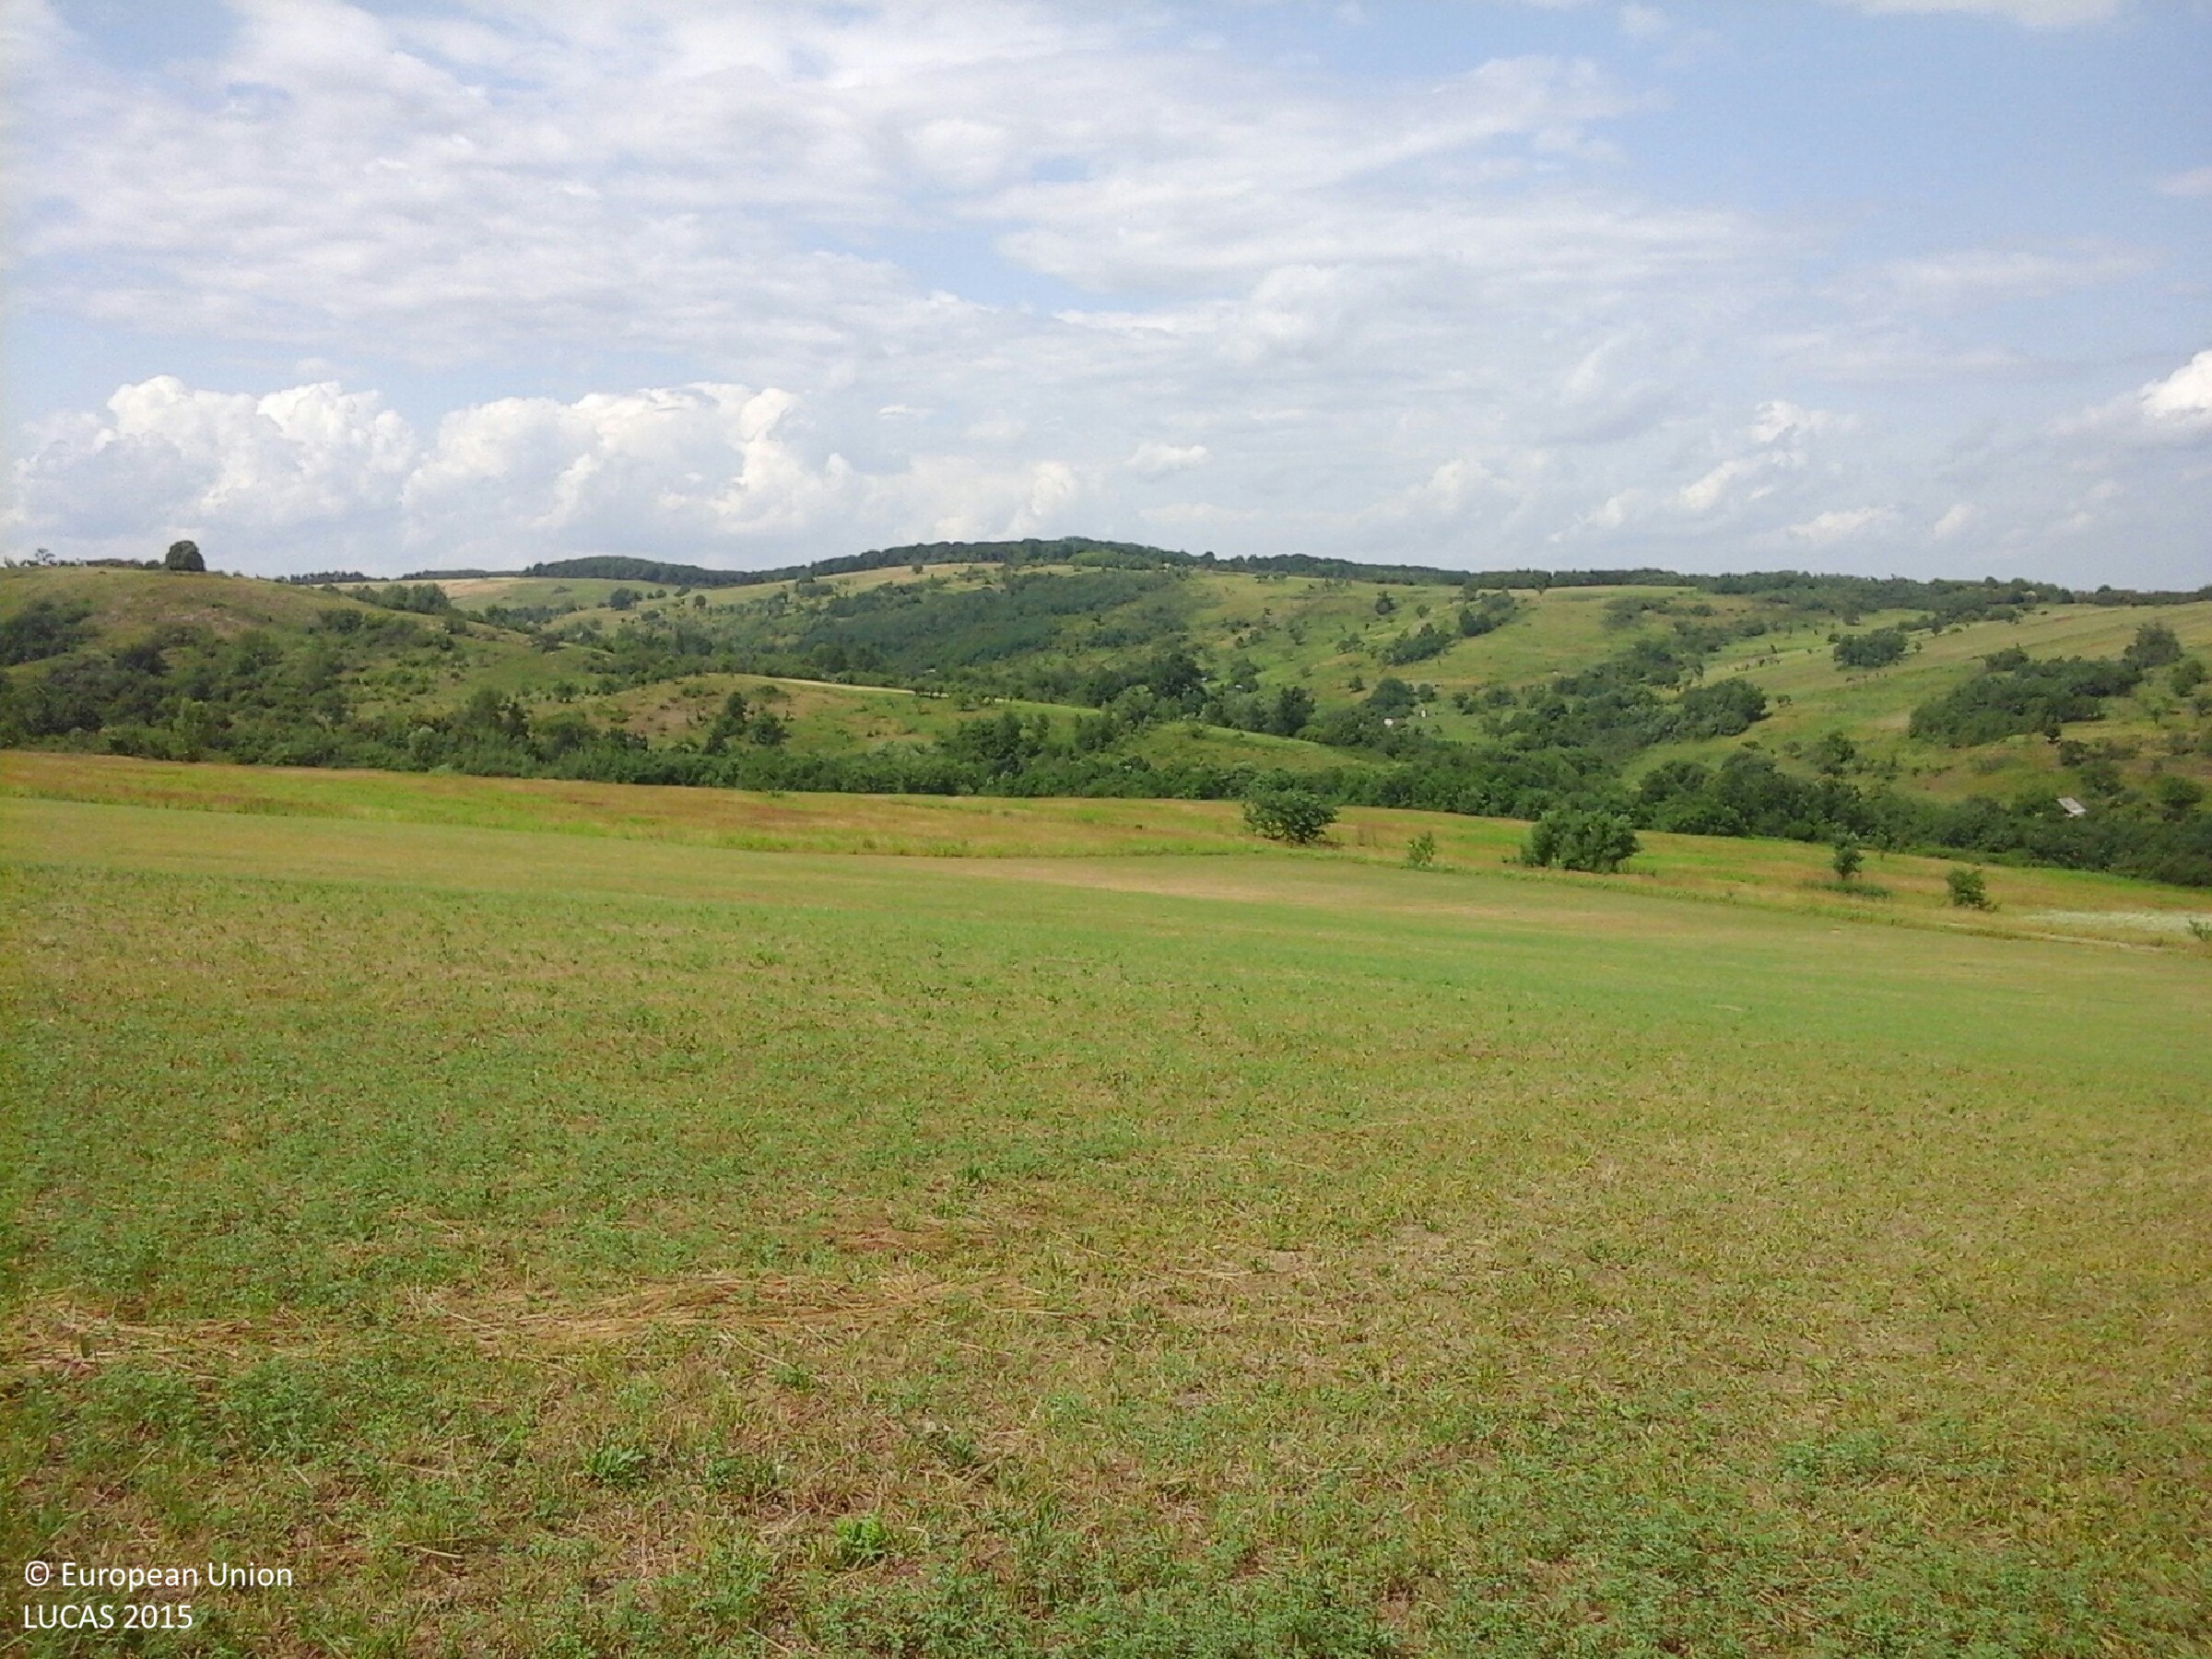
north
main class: Cropland
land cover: Lucerne
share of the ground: > 75 %
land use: Agriculture (excluding fallow land and kitchen gardens)
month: July
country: HU
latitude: 48.1324
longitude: 20.7456
